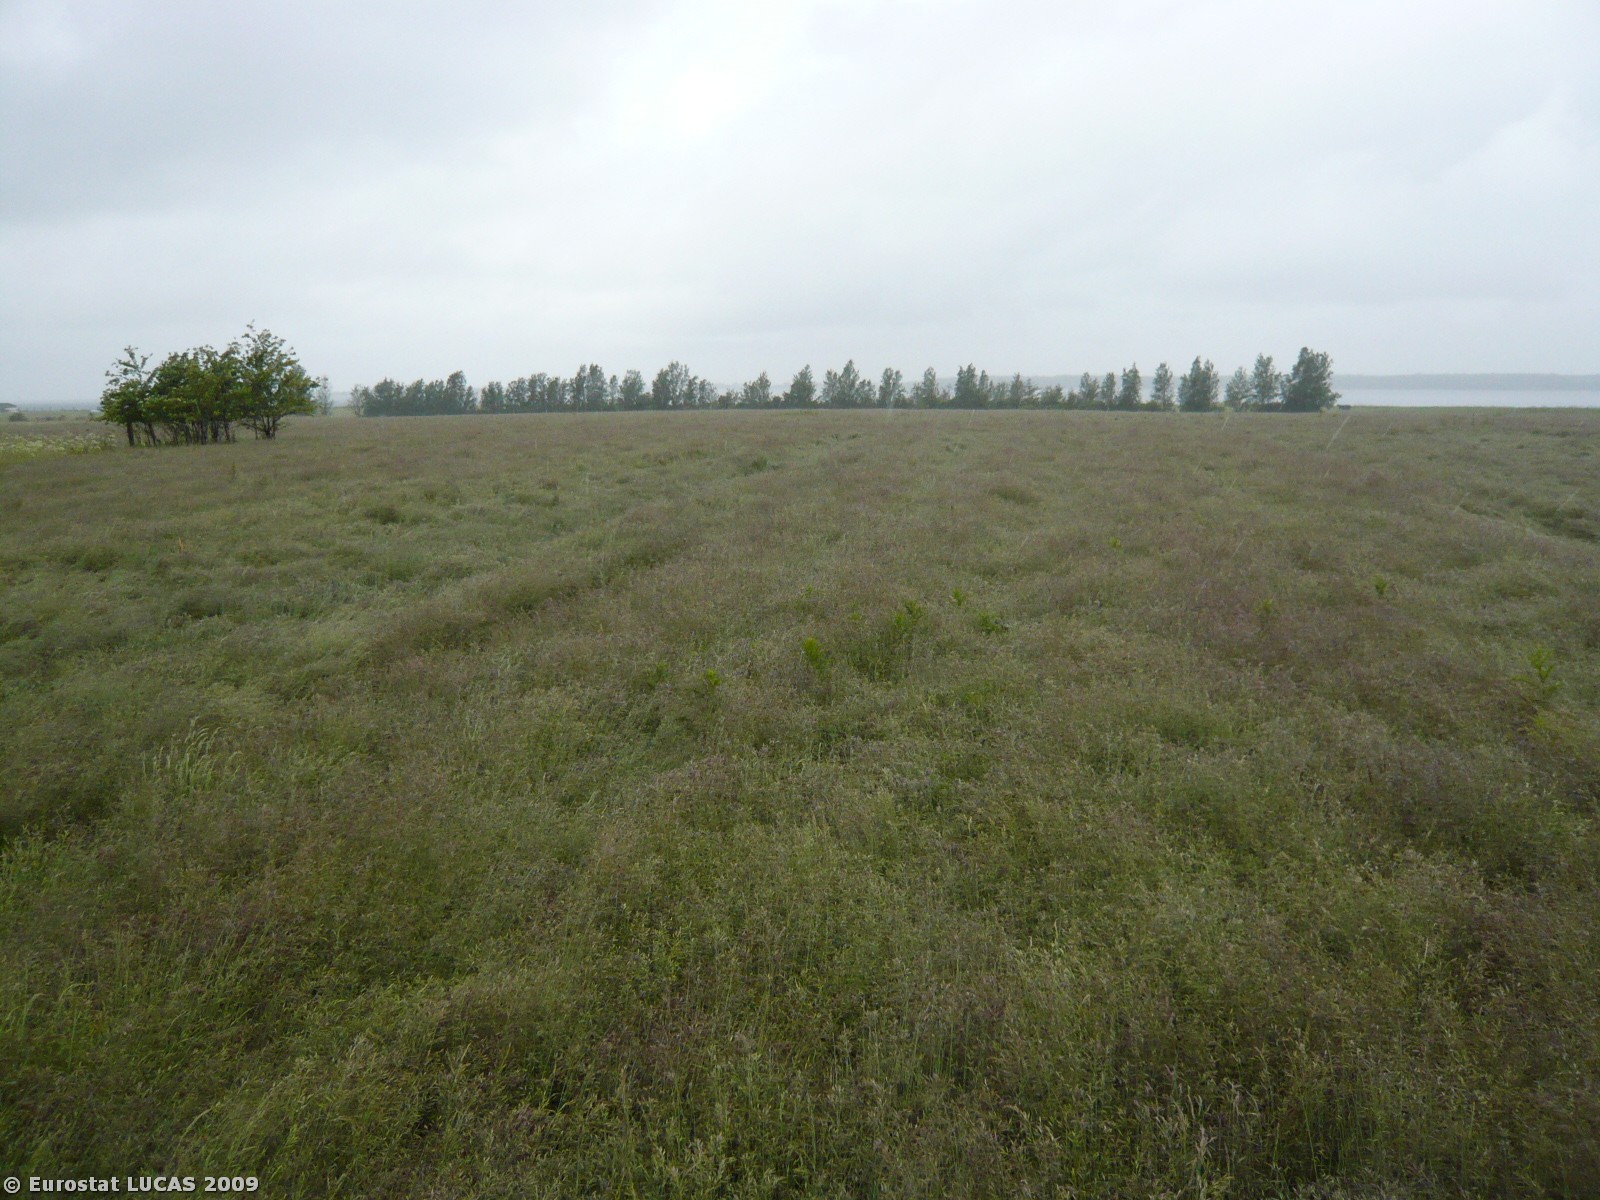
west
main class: Cropland
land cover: Temporary grasslands
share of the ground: > 75 %
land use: Agriculture (excluding fallow land and kitchen gardens)
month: June
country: DK
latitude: 54.6638
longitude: 11.8748
